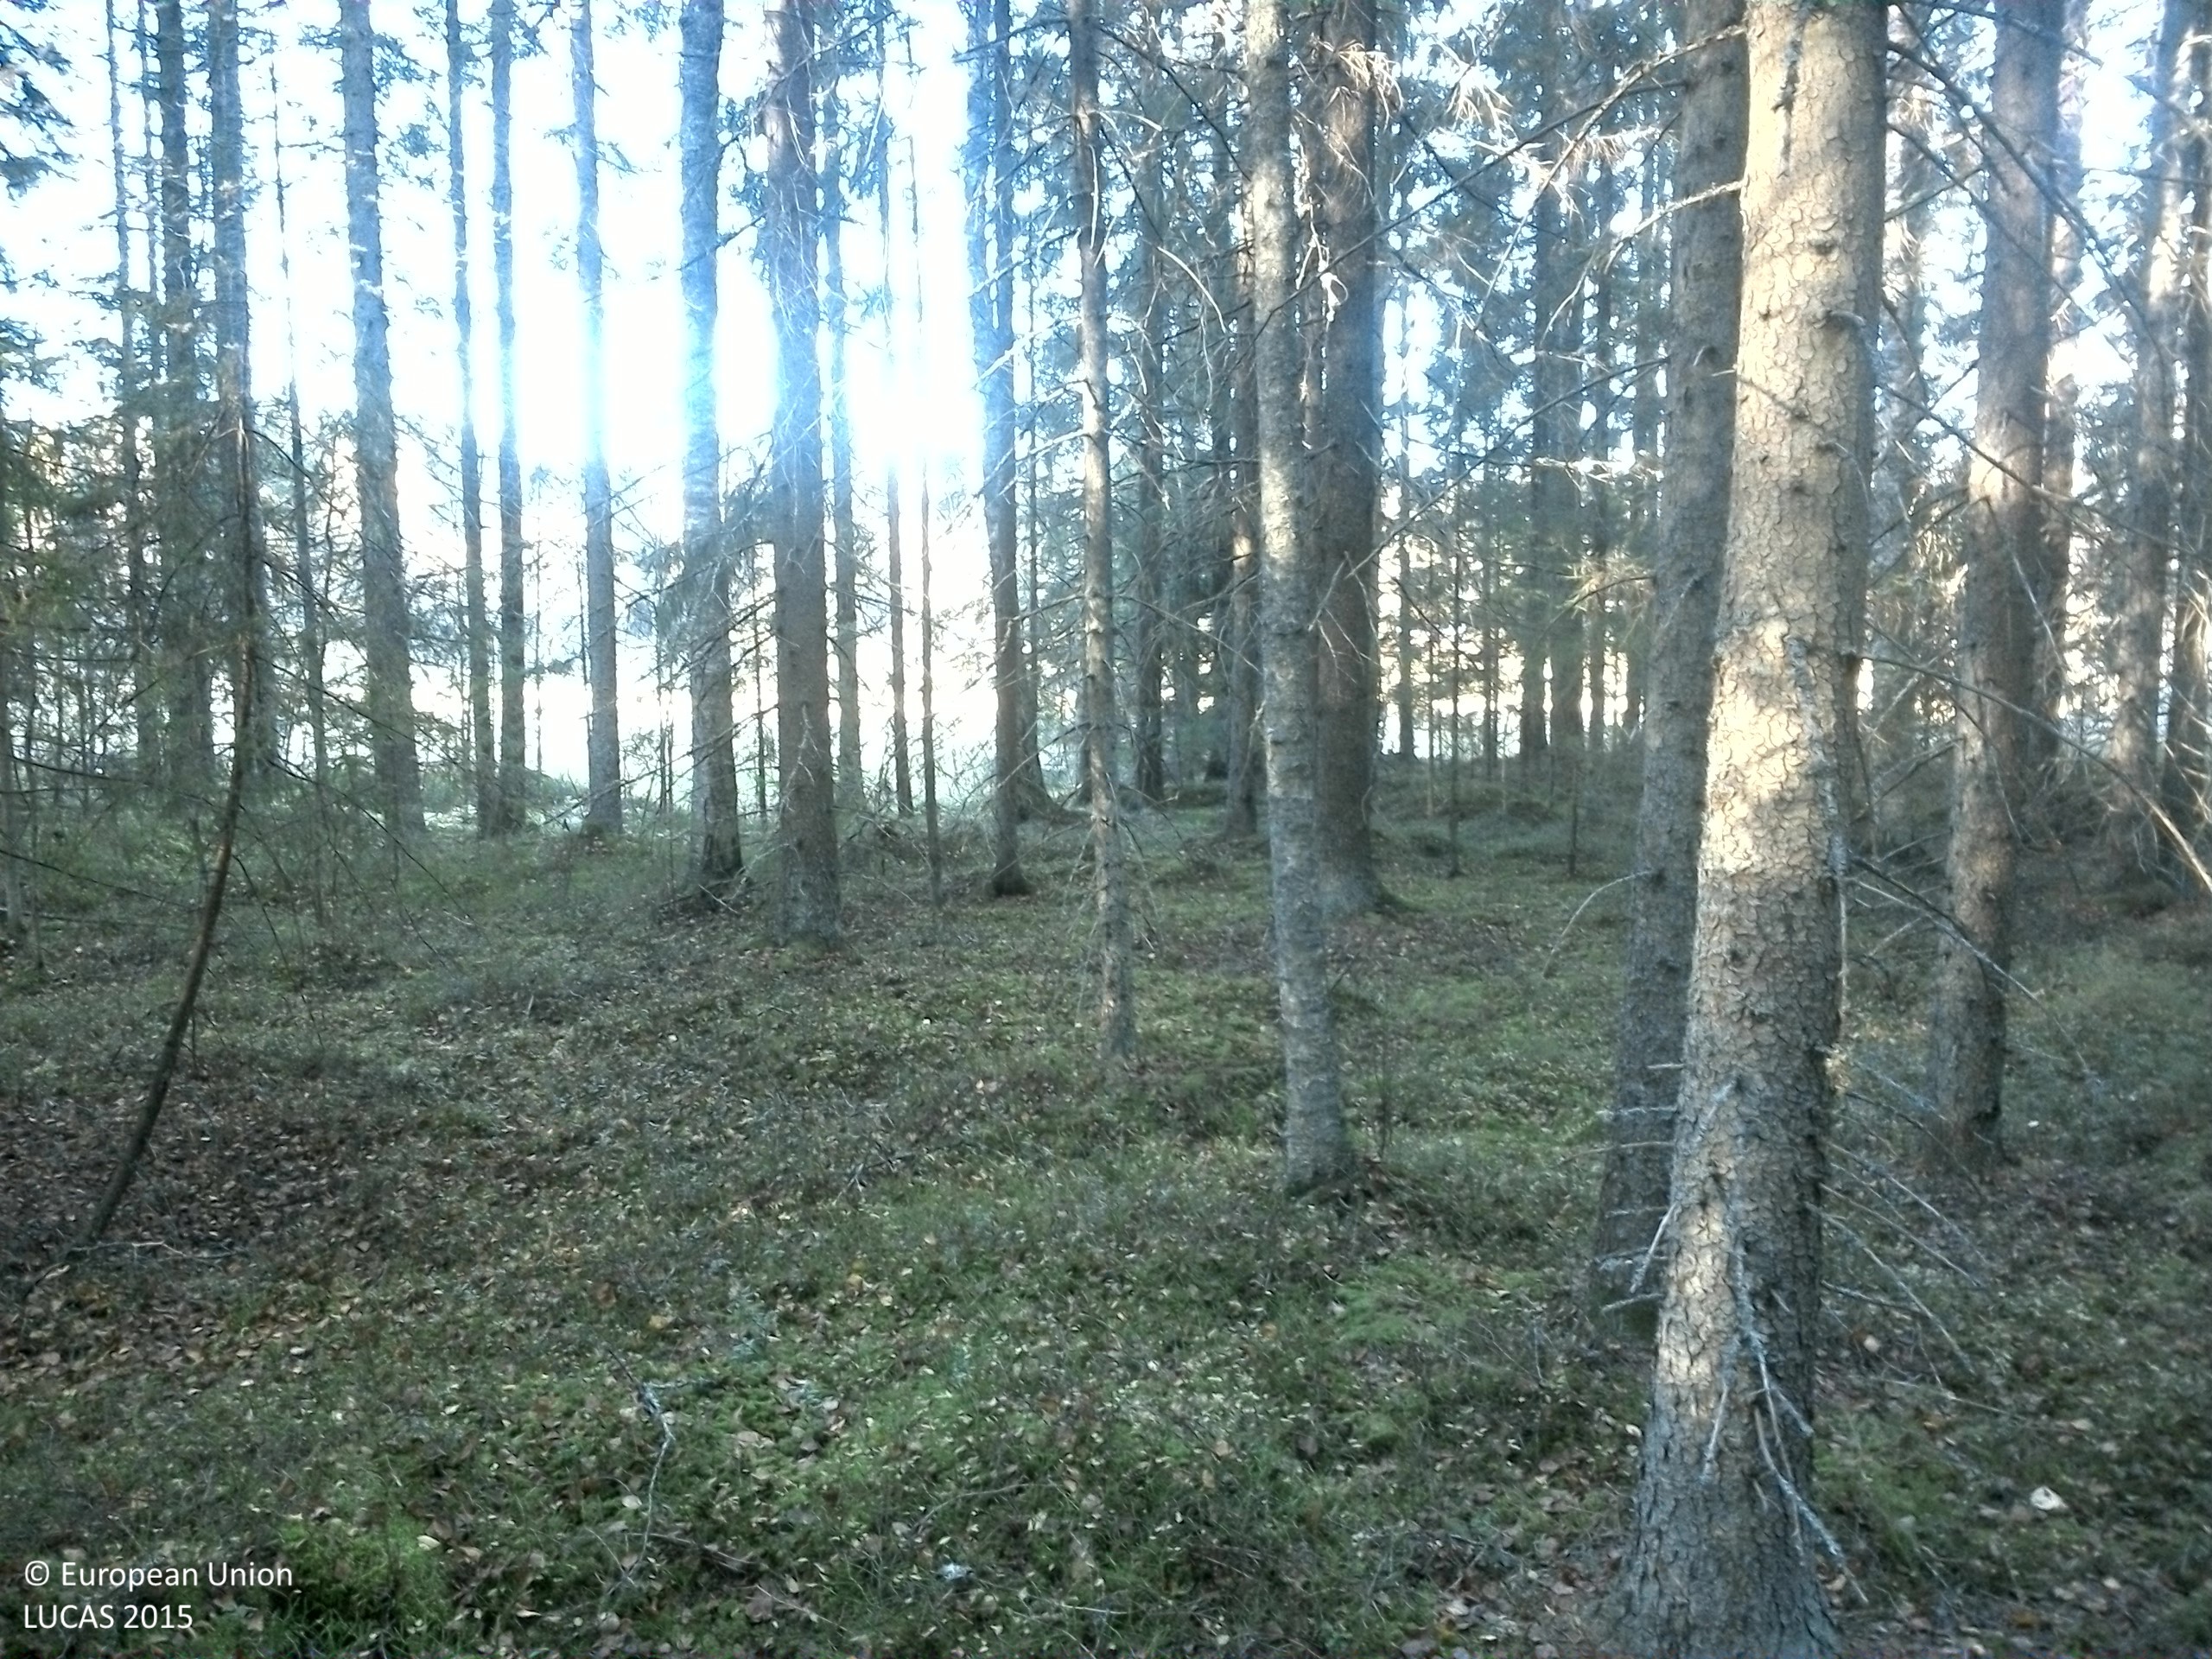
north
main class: Woodland
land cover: Spruce dominated coniferous woodland
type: boreal forest
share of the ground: > 75 %
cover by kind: coniferous forest trees 75 %, shrubs 15 %, lichens and mosses 10 %
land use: Forestry
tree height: > 5 m
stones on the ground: < 10 %
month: October
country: SE
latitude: 59.5625
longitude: 15.1760
